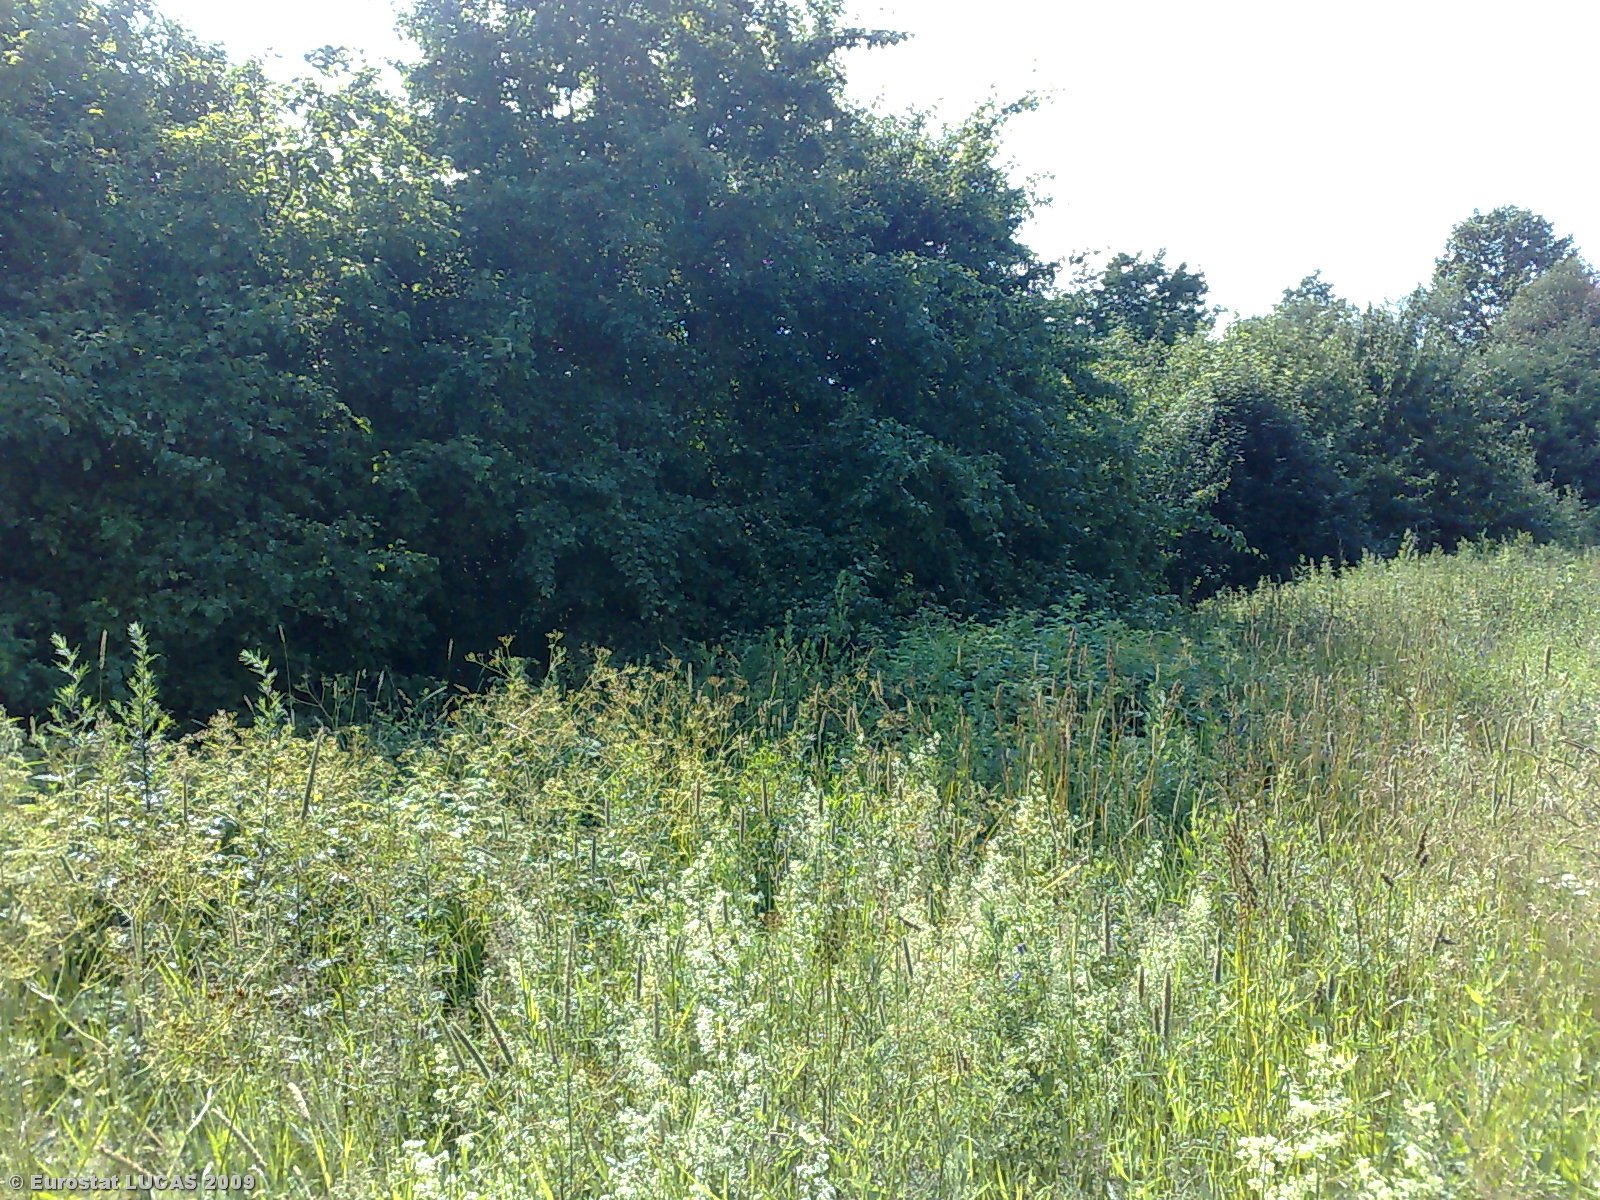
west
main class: Grassland
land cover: Grassland without tree/shrub cover
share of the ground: > 75 %
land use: Agriculture (excluding fallow land and kitchen gardens)
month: July
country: LT
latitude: 55.4975
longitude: 22.7125
